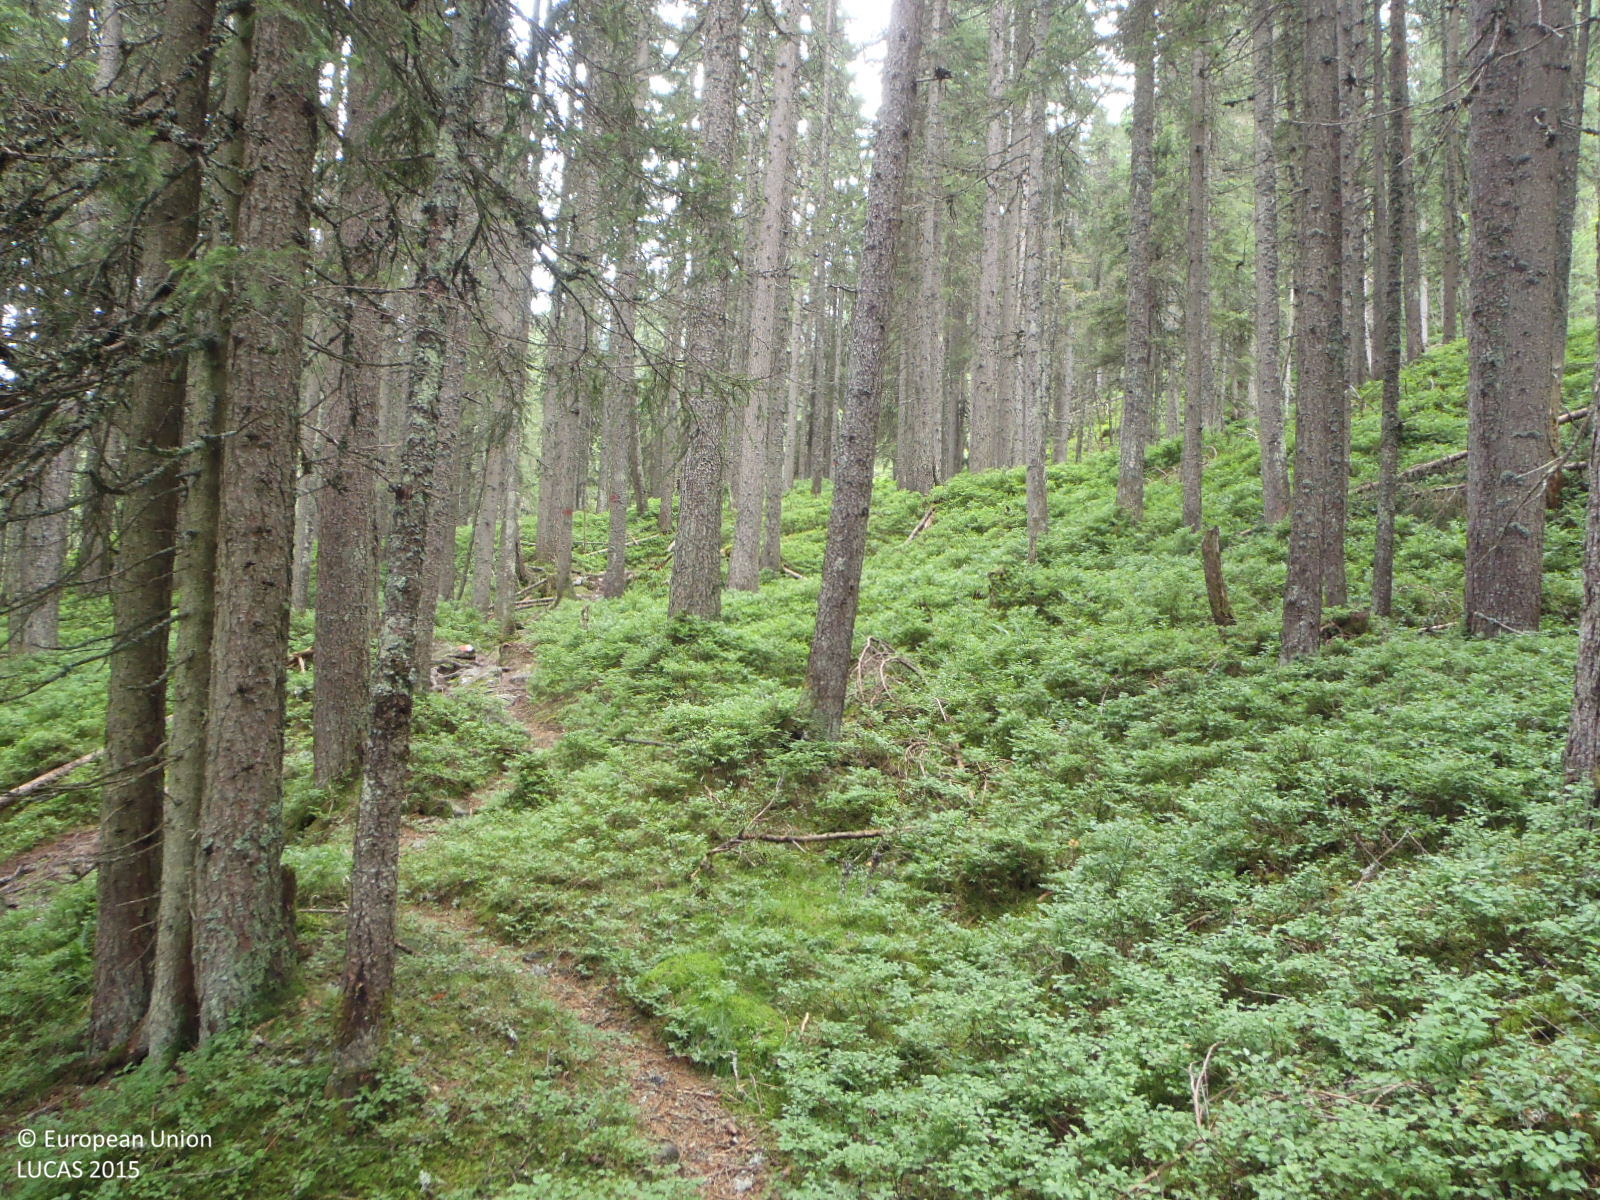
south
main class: Woodland
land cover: Spruce dominated coniferous woodland
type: alpine coniferous forest
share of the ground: > 75 %
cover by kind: coniferous forest trees 90 %, shrubs 10 %
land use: Forestry
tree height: > 5 m
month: July
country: AT
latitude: 47.3265
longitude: 11.8112
